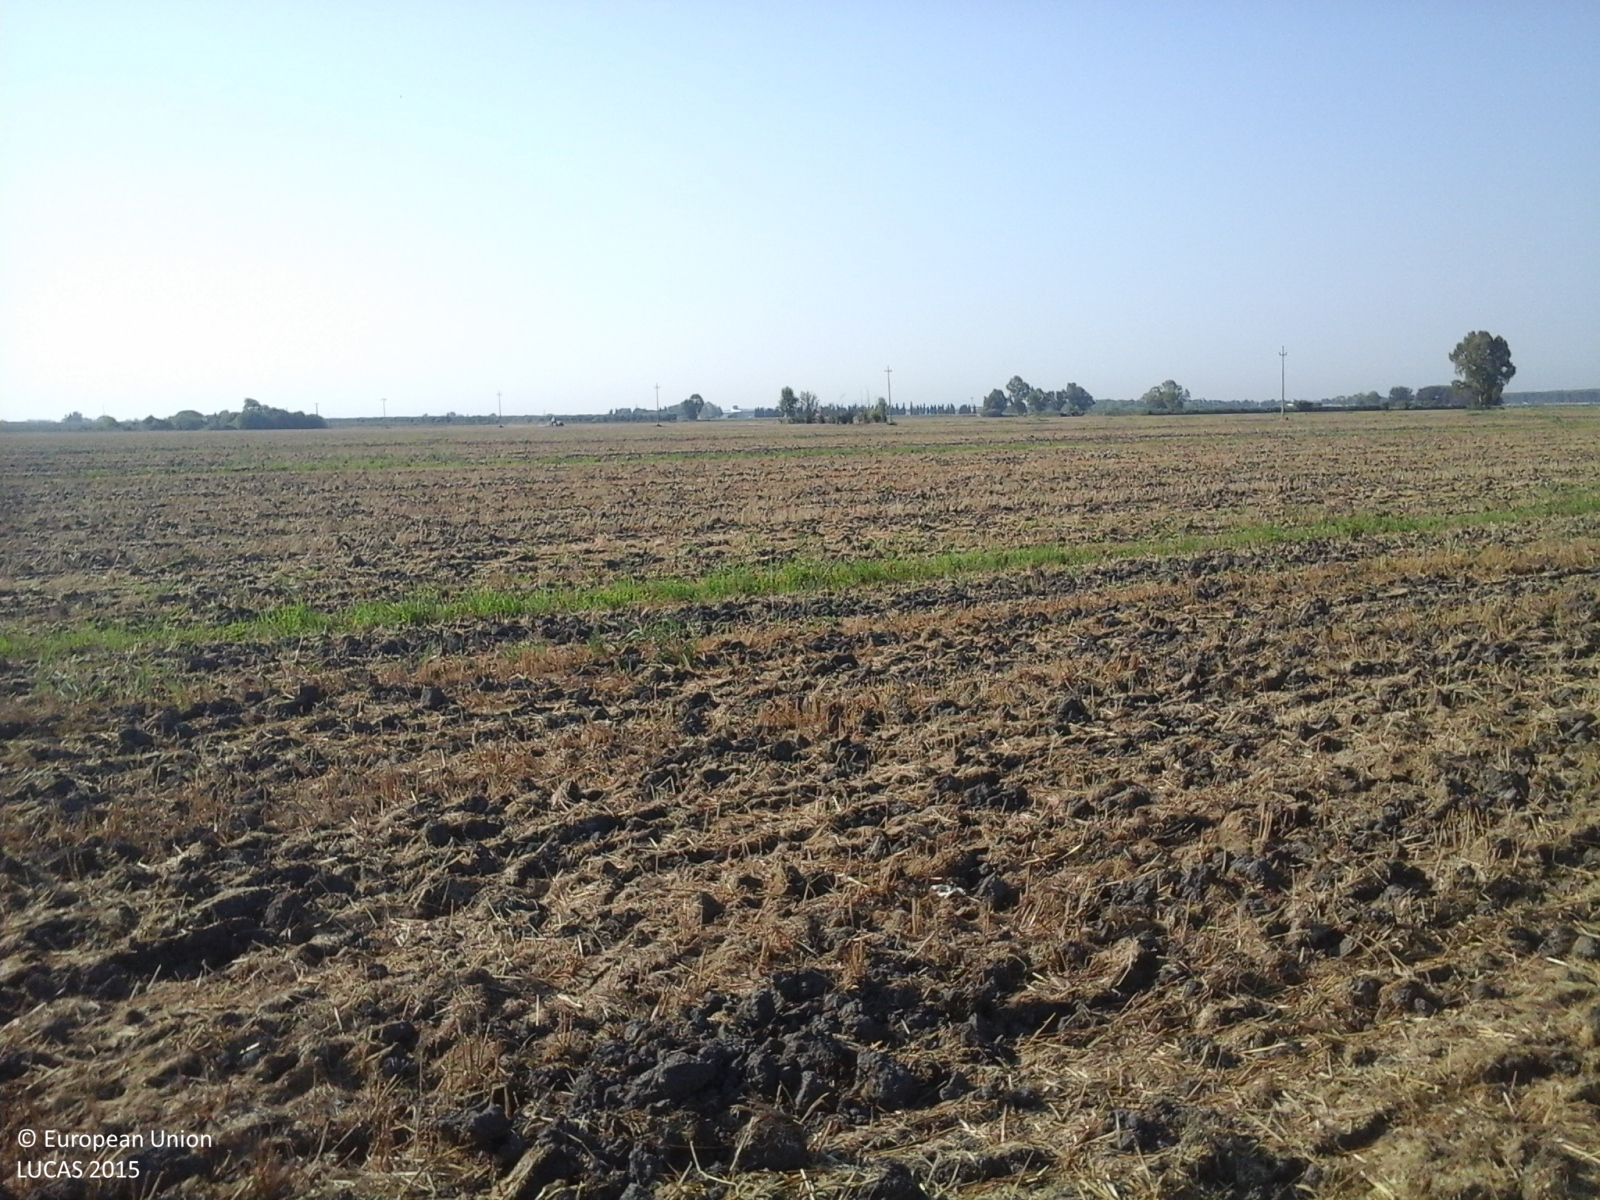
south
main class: Cropland
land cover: Common wheat
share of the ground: > 75 %
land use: Agriculture (excluding fallow land and kitchen gardens)
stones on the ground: < 10 %
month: August
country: IT
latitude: 43.8088
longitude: 10.3347
